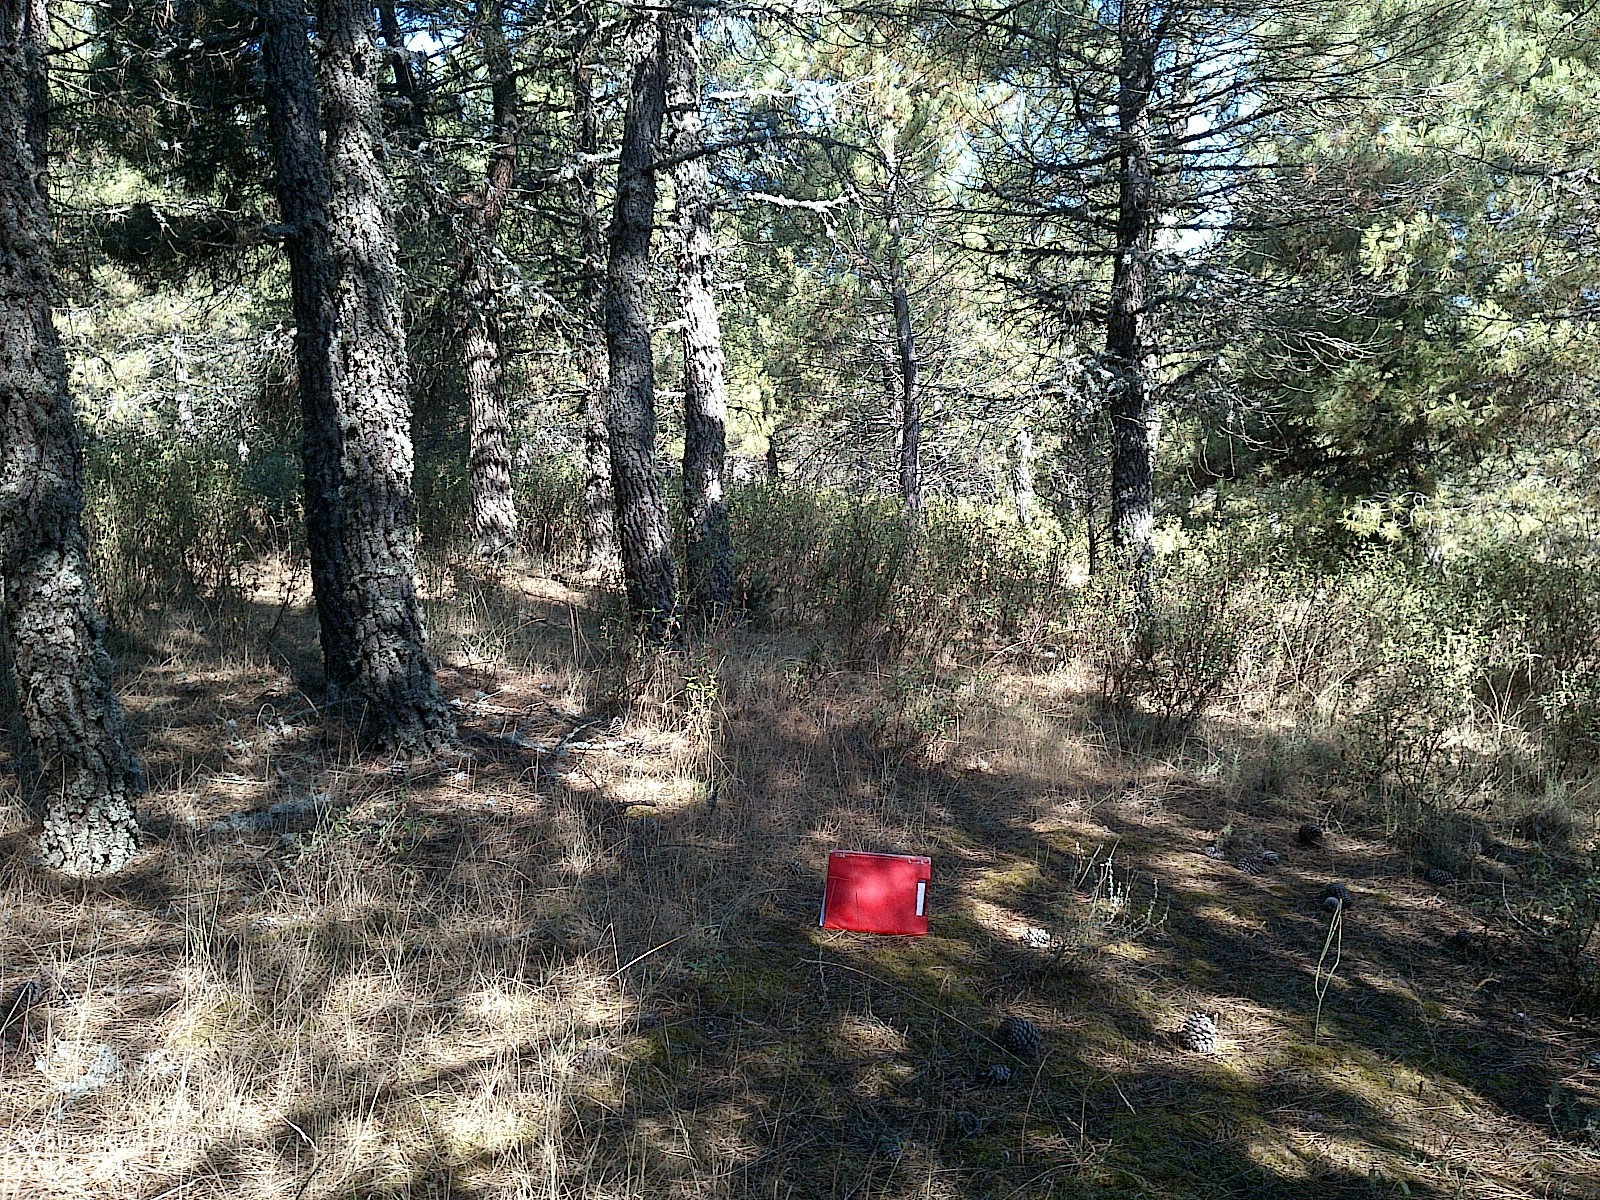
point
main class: Woodland
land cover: Pine dominated coniferous woodland
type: coniferous forest of the mediterranean region
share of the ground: > 75 %
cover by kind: coniferous forest trees 85 %, shrubs 10 %, lichens and mosses 5 %
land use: Forestry
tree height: > 5 m
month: July
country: ES
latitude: 41.7746
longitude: -3.1476
